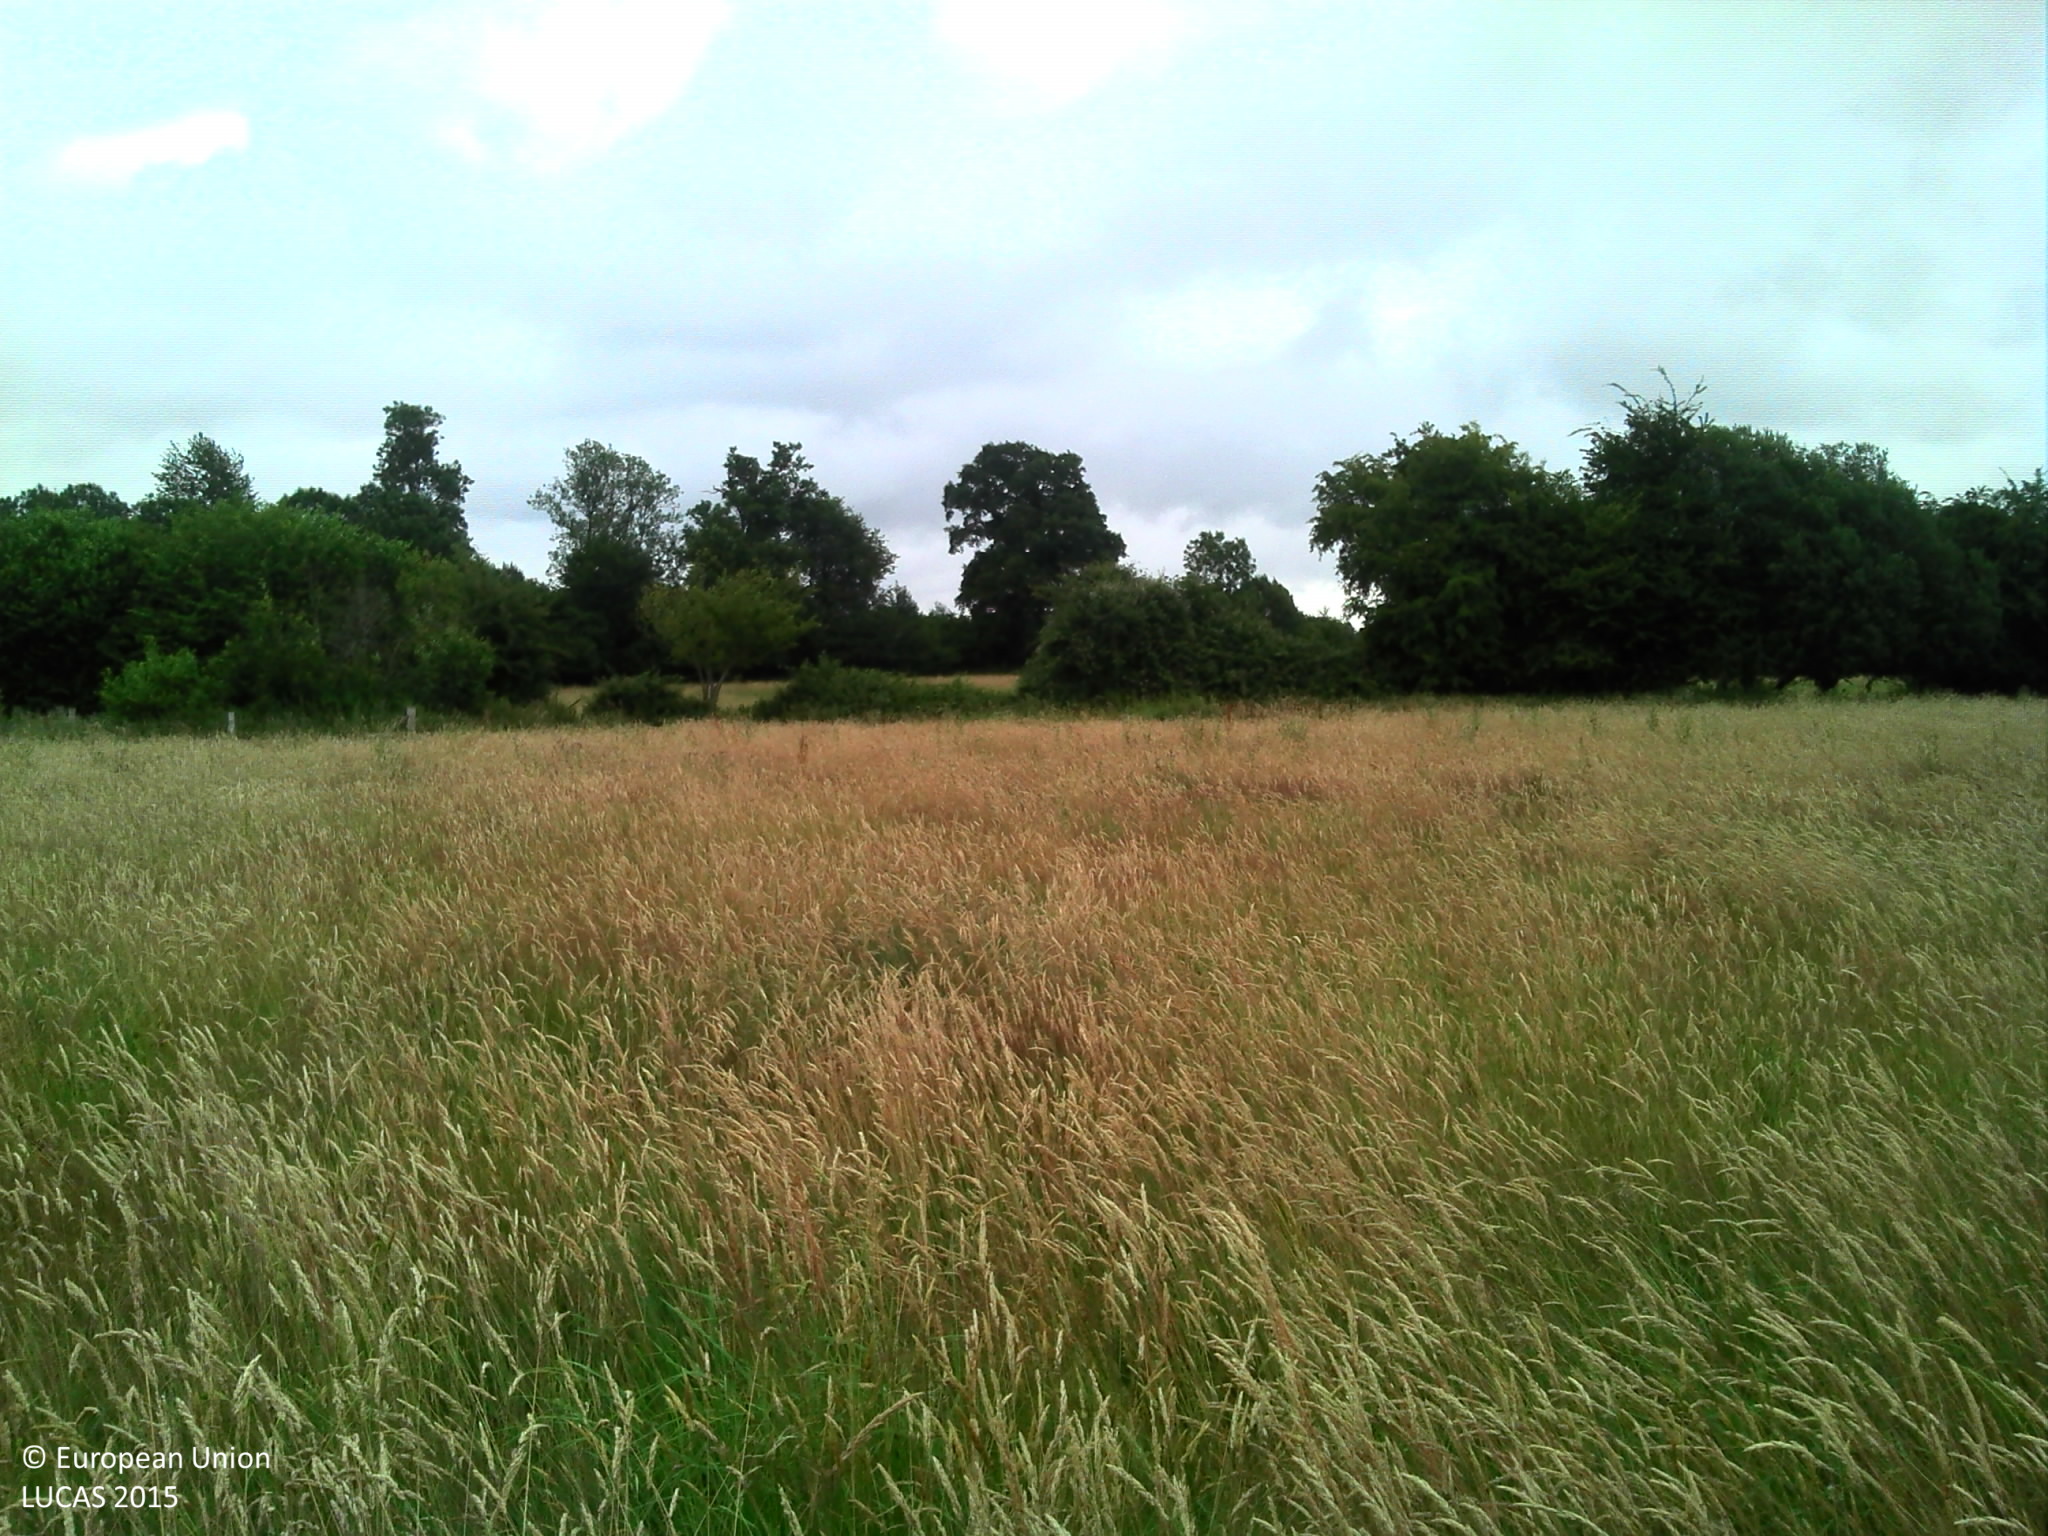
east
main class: Grassland
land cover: Grassland without tree/shrub cover
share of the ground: > 75 %
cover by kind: herbaceous plants 100 %
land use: Agriculture (excluding fallow land and kitchen gardens)
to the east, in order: Grassland without tree/shrub cover; Abandoned hedges; Fences; Grassland without tree/shrub cover; Broadleaved woodland; Fences; Grassland without tree/shrub cover
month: July
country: FR
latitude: 49.3418
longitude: 0.3792
